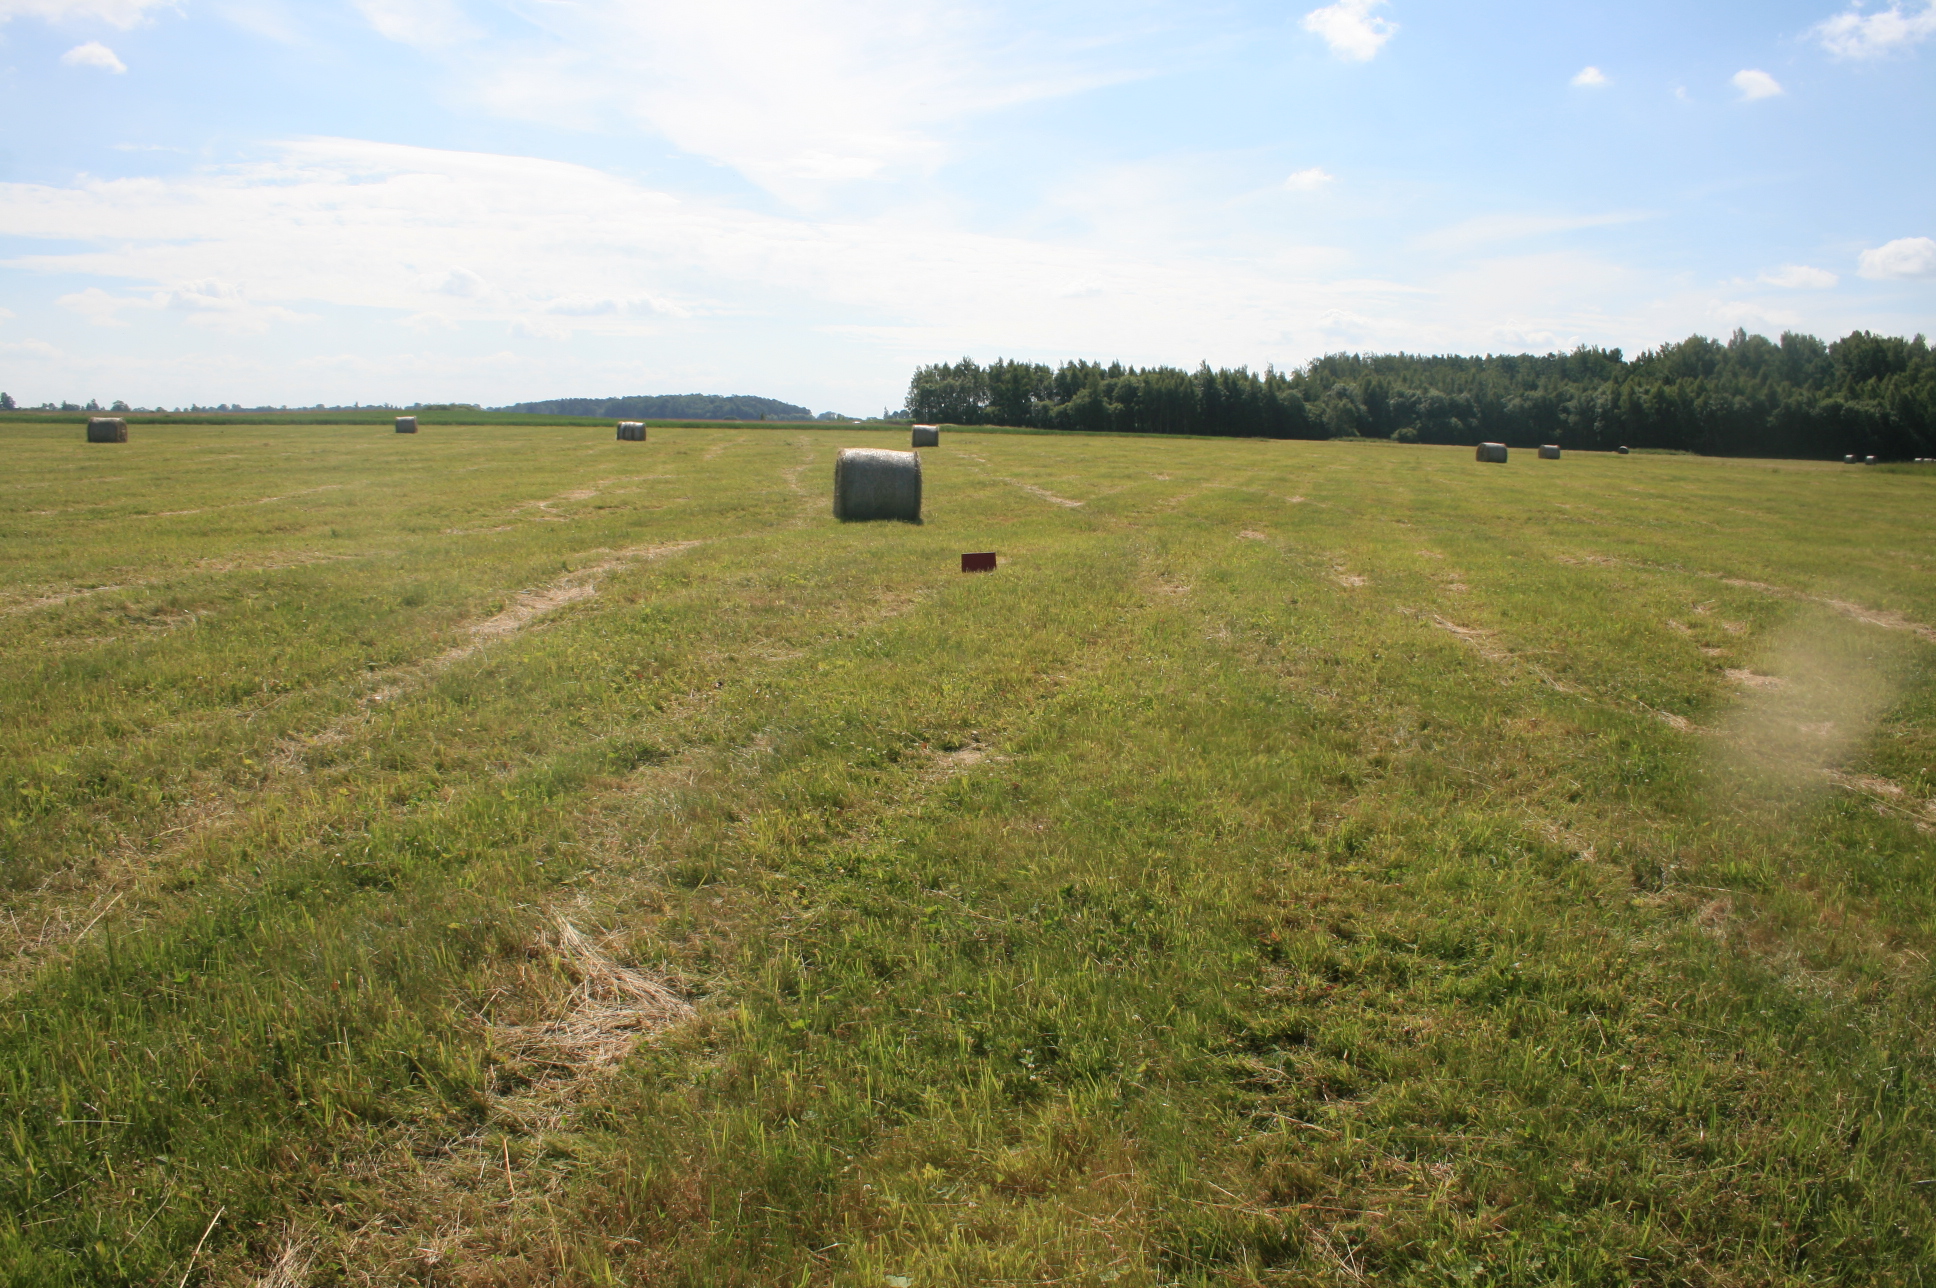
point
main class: Grassland
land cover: Grassland without tree/shrub cover
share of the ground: > 75 %
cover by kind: herbaceous plants 100 %
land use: Agriculture (excluding fallow land and kitchen gardens)
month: June
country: LT
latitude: 55.2970
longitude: 21.7840
